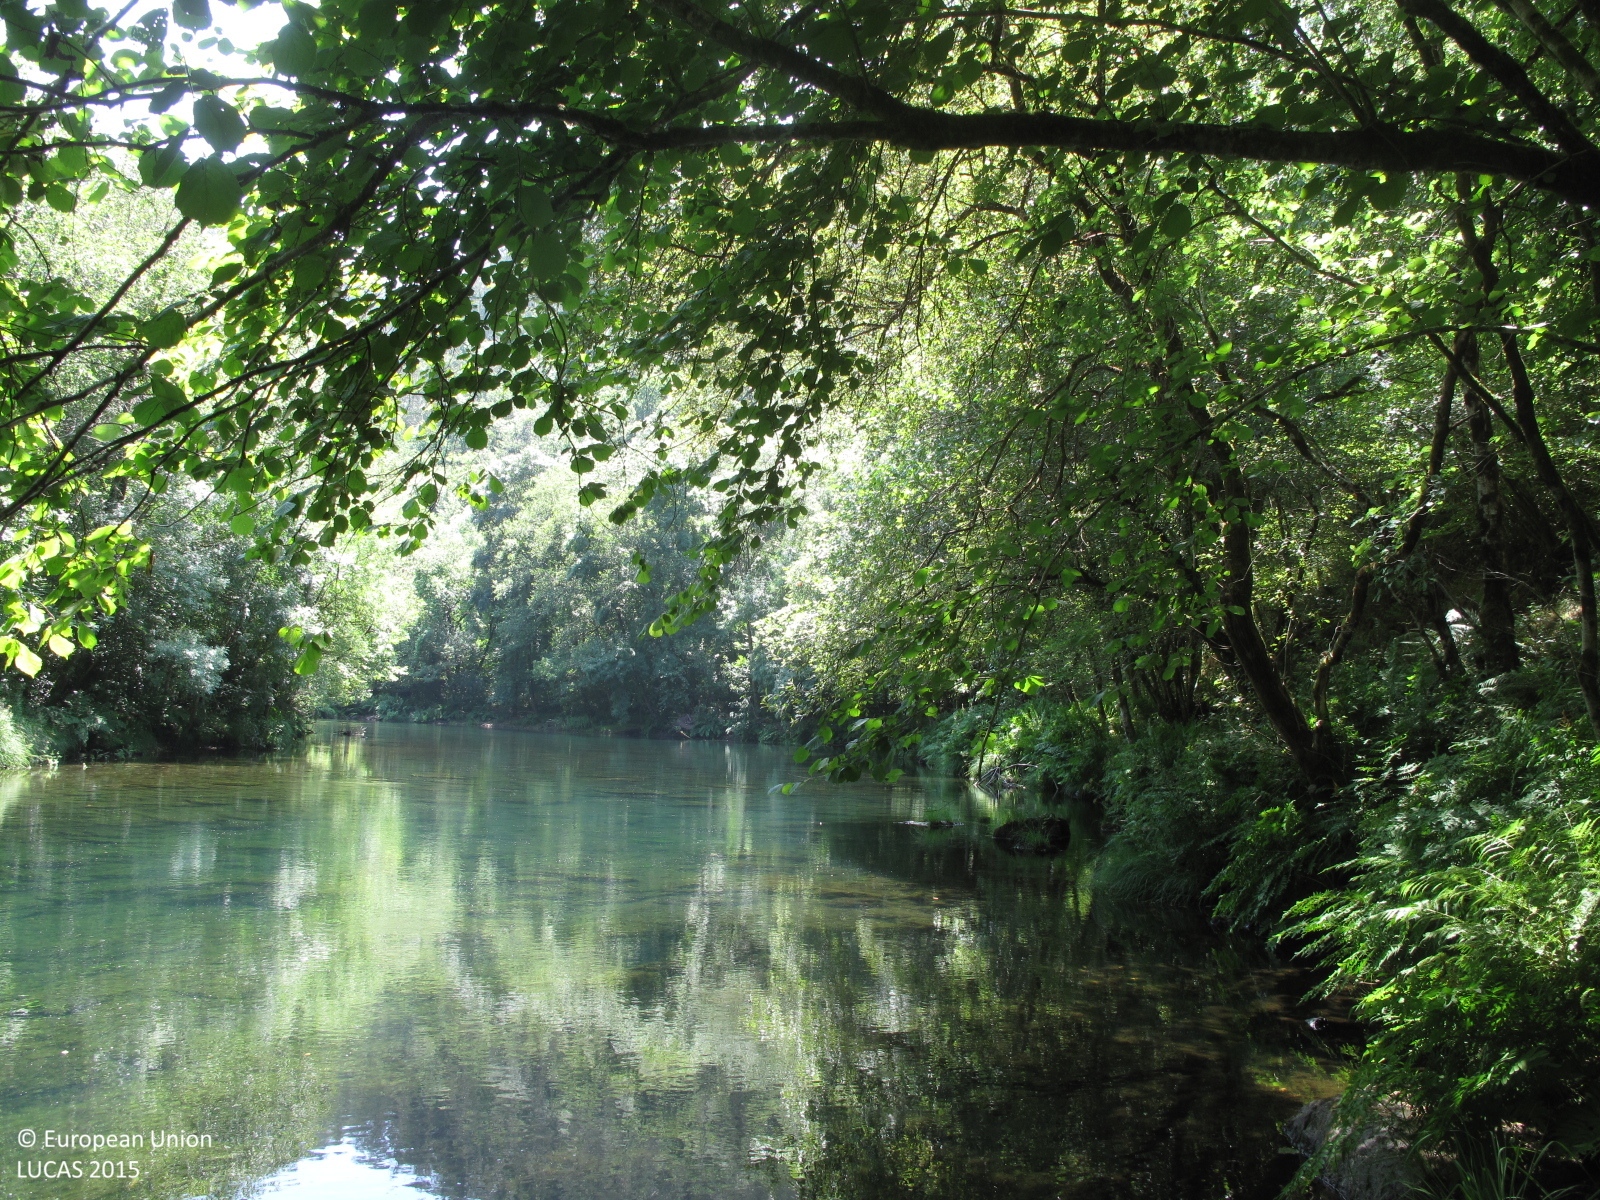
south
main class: Woodland
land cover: Broadleaved woodland
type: acidophilous oak and oak-birch forest
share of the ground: > 75 %
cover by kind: broadleaved forest trees 100 %
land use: Semi-natural and natural areas not in use
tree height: > 5 m
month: July
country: ES
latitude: 43.4085
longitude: -8.0899
